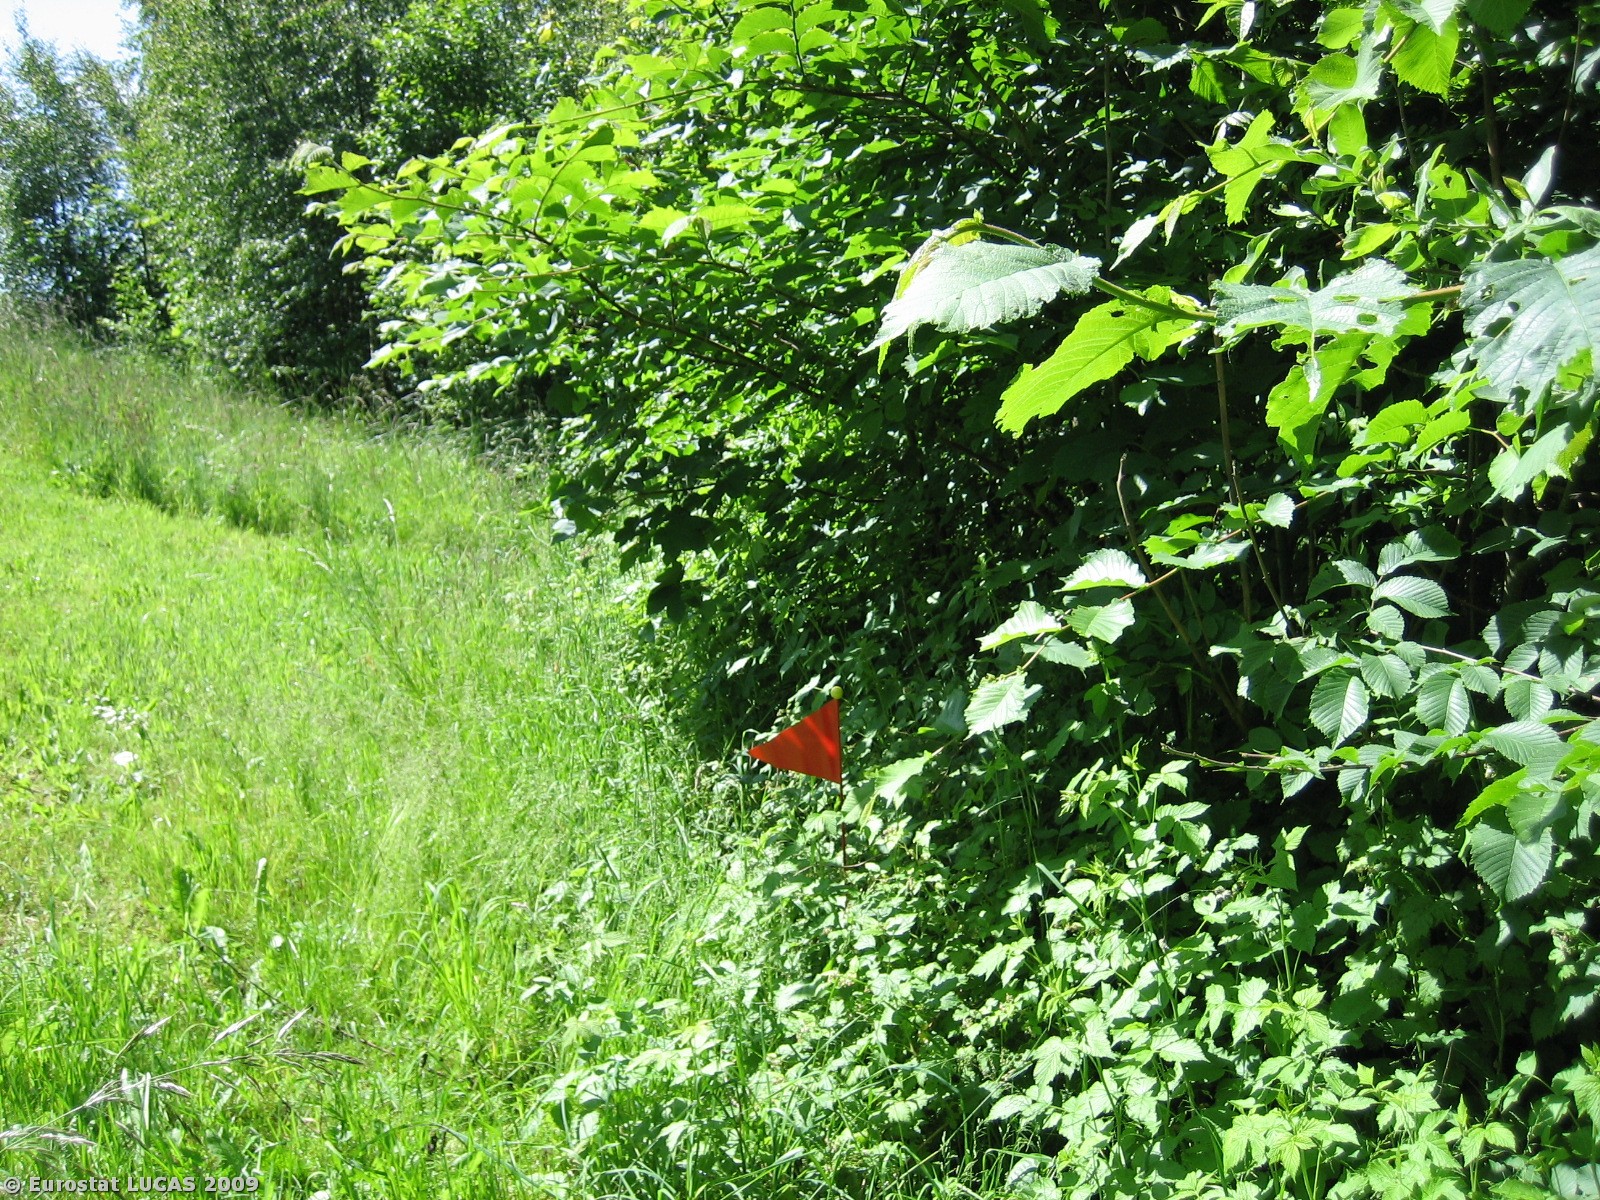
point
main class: Woodland
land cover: Broadleaved woodland
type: mesophytic deciduous forest
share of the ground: > 75 %
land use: Residential
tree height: > 5 m
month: June
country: DK
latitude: 55.9540
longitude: 9.8560
